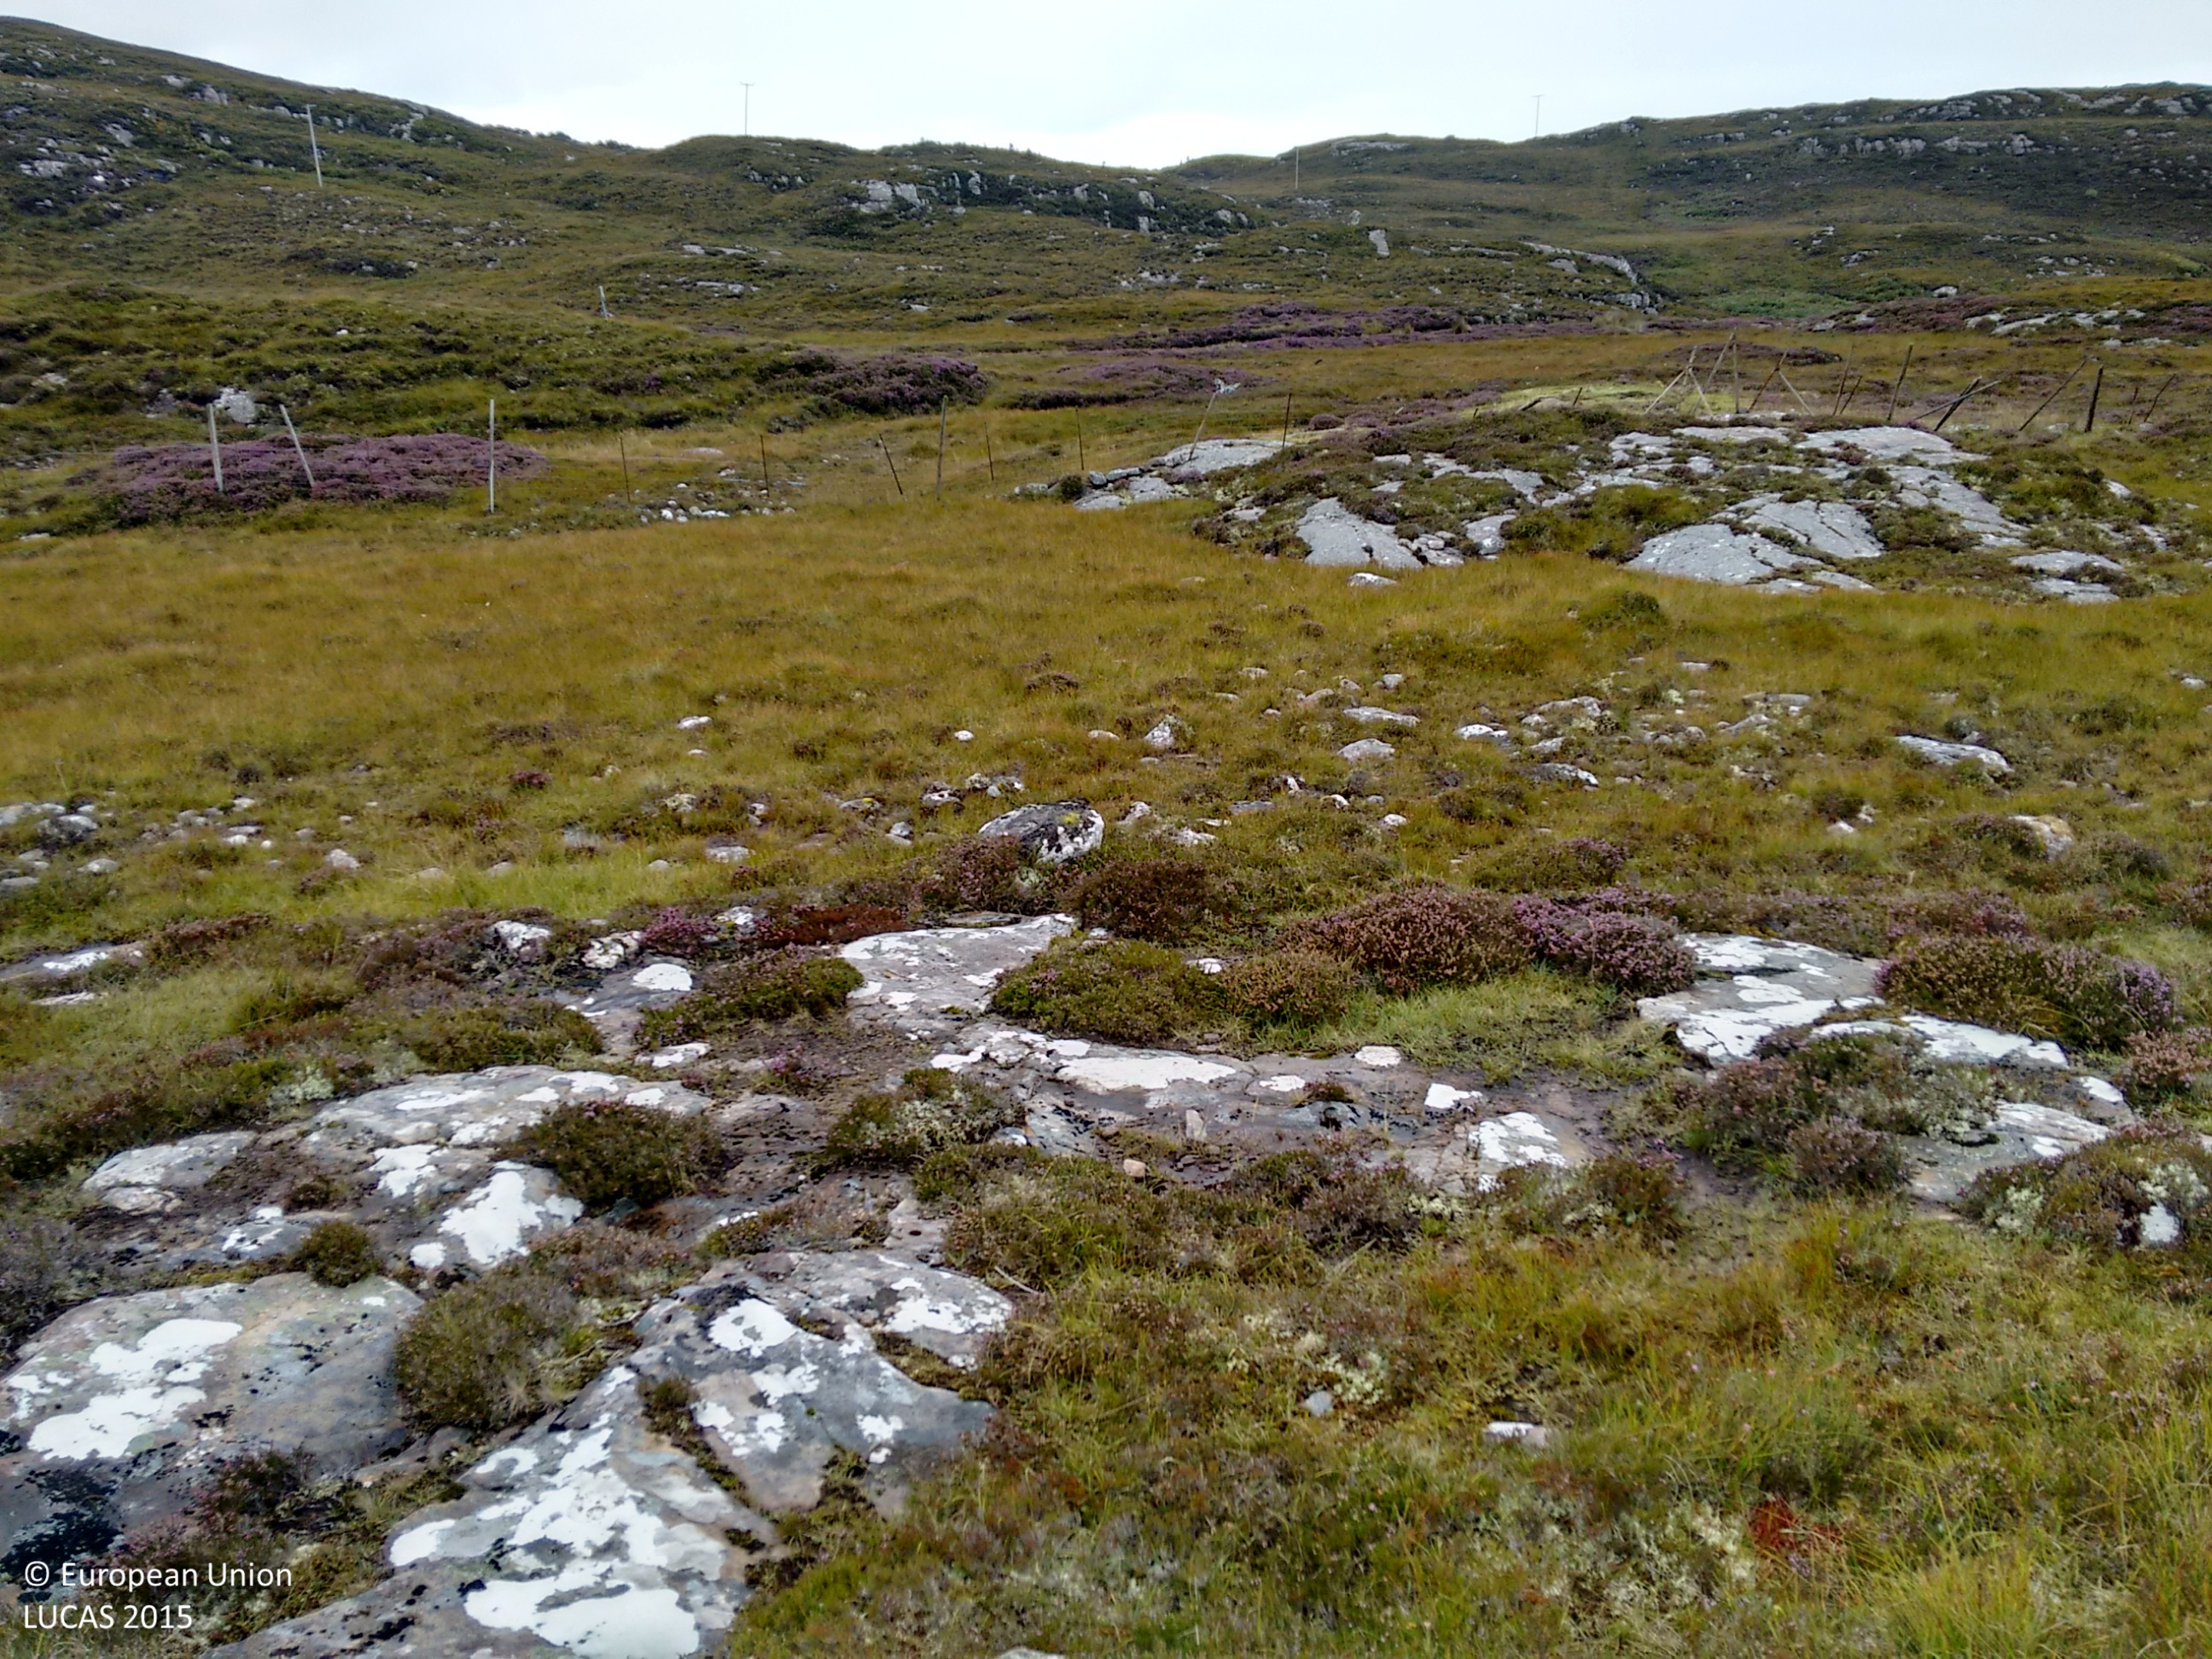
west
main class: Shrubland
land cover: Shrubland without tree cover
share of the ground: > 75 %
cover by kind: shrubs 70 %, herbaceous plants 20 %, unconsolidated bare surface 10 %
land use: Agriculture (excluding fallow land and kitchen gardens)
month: September
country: GB
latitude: 57.5714
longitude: -5.7887
